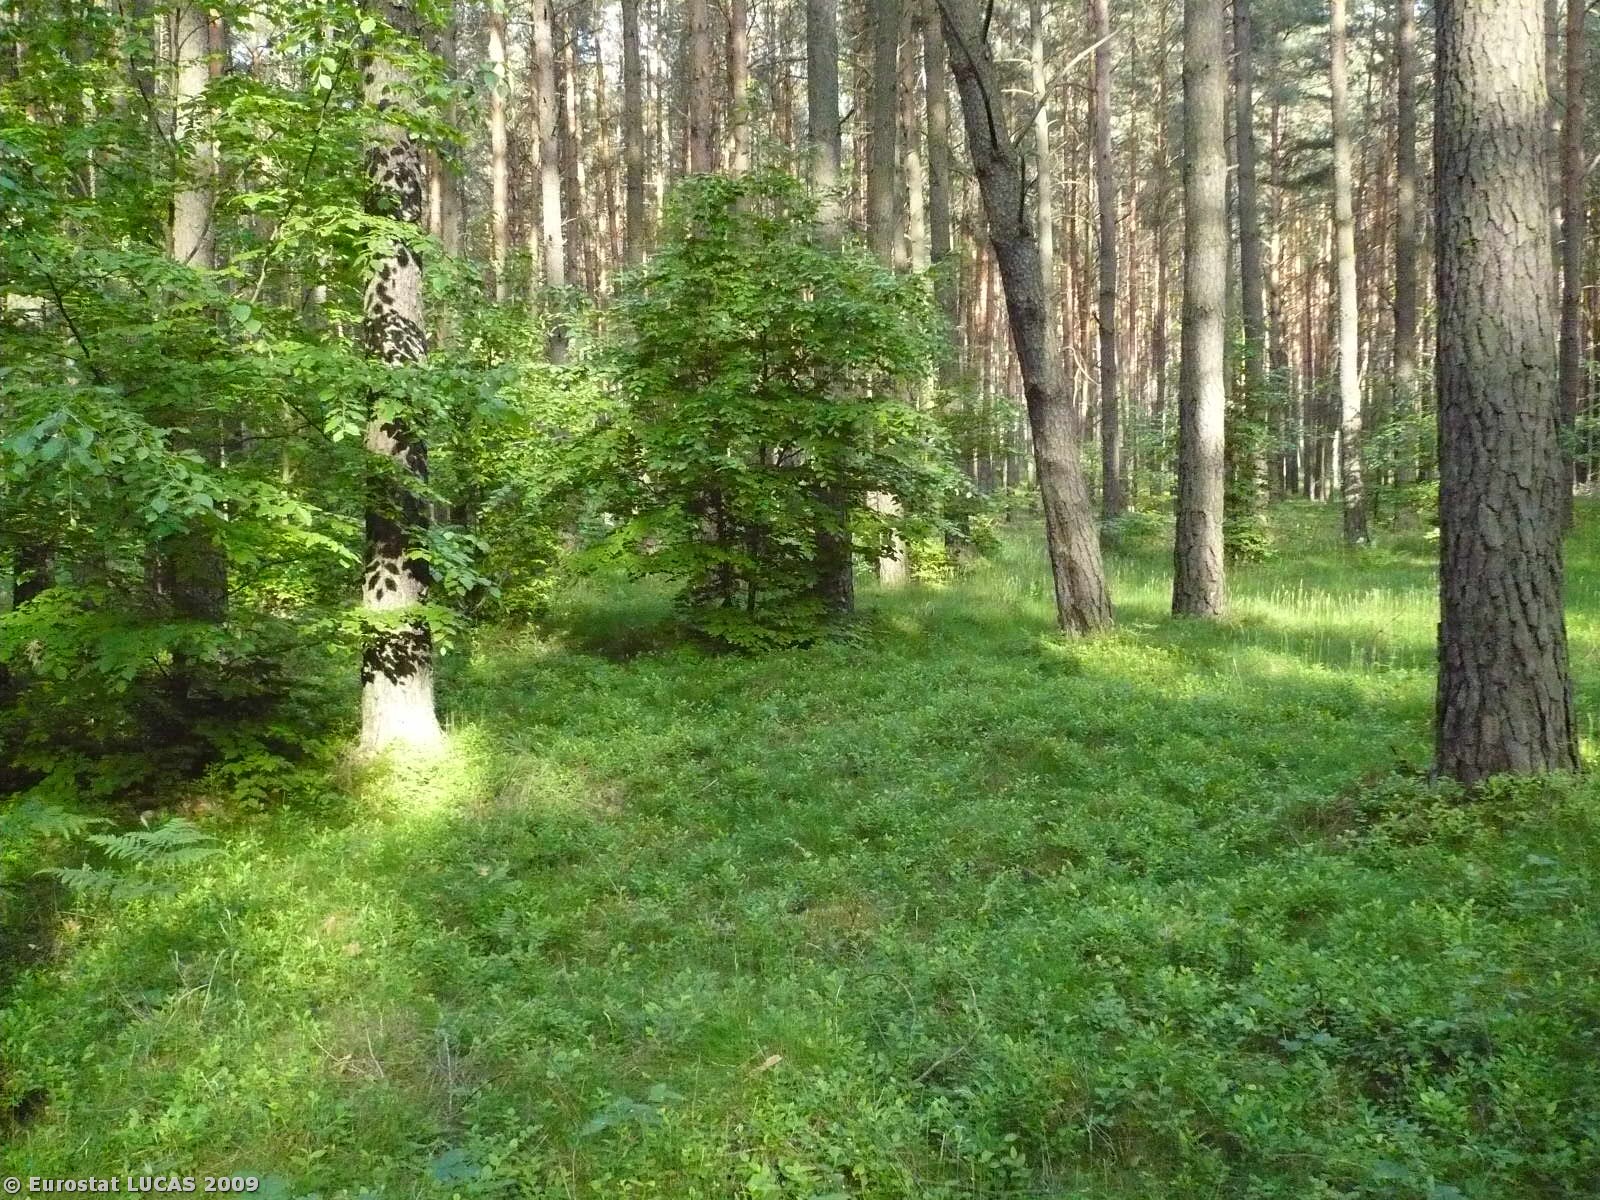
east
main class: Woodland
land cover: Coniferous woodland
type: hemiboreal forest and nemoral coniferous forest and mixed broadleaved-coniferous forest
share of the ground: > 75 %
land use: Forestry
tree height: > 5 m
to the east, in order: Coniferous woodland
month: May
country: PL
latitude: 52.1008
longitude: 15.2150
